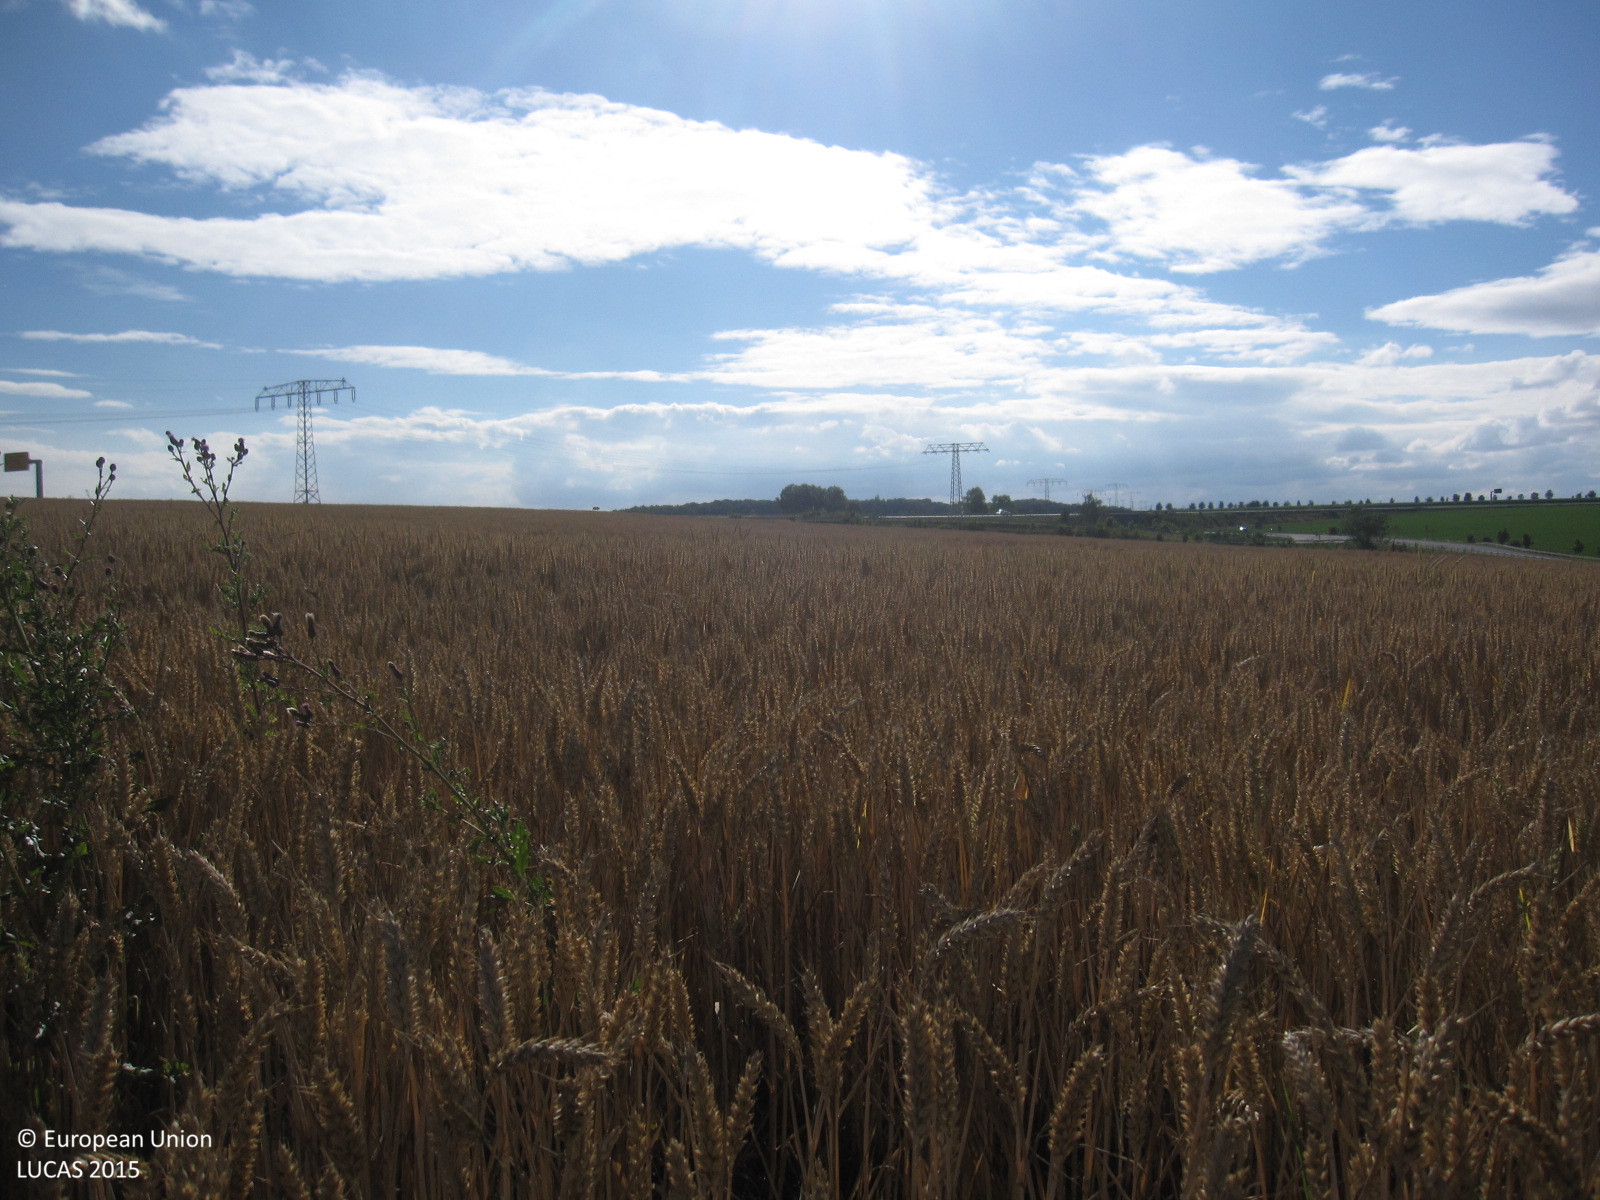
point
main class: Cropland
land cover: Common wheat
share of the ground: > 75 %
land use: Agriculture (excluding fallow land and kitchen gardens)
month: July
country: DE
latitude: 50.9380
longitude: 12.1201
